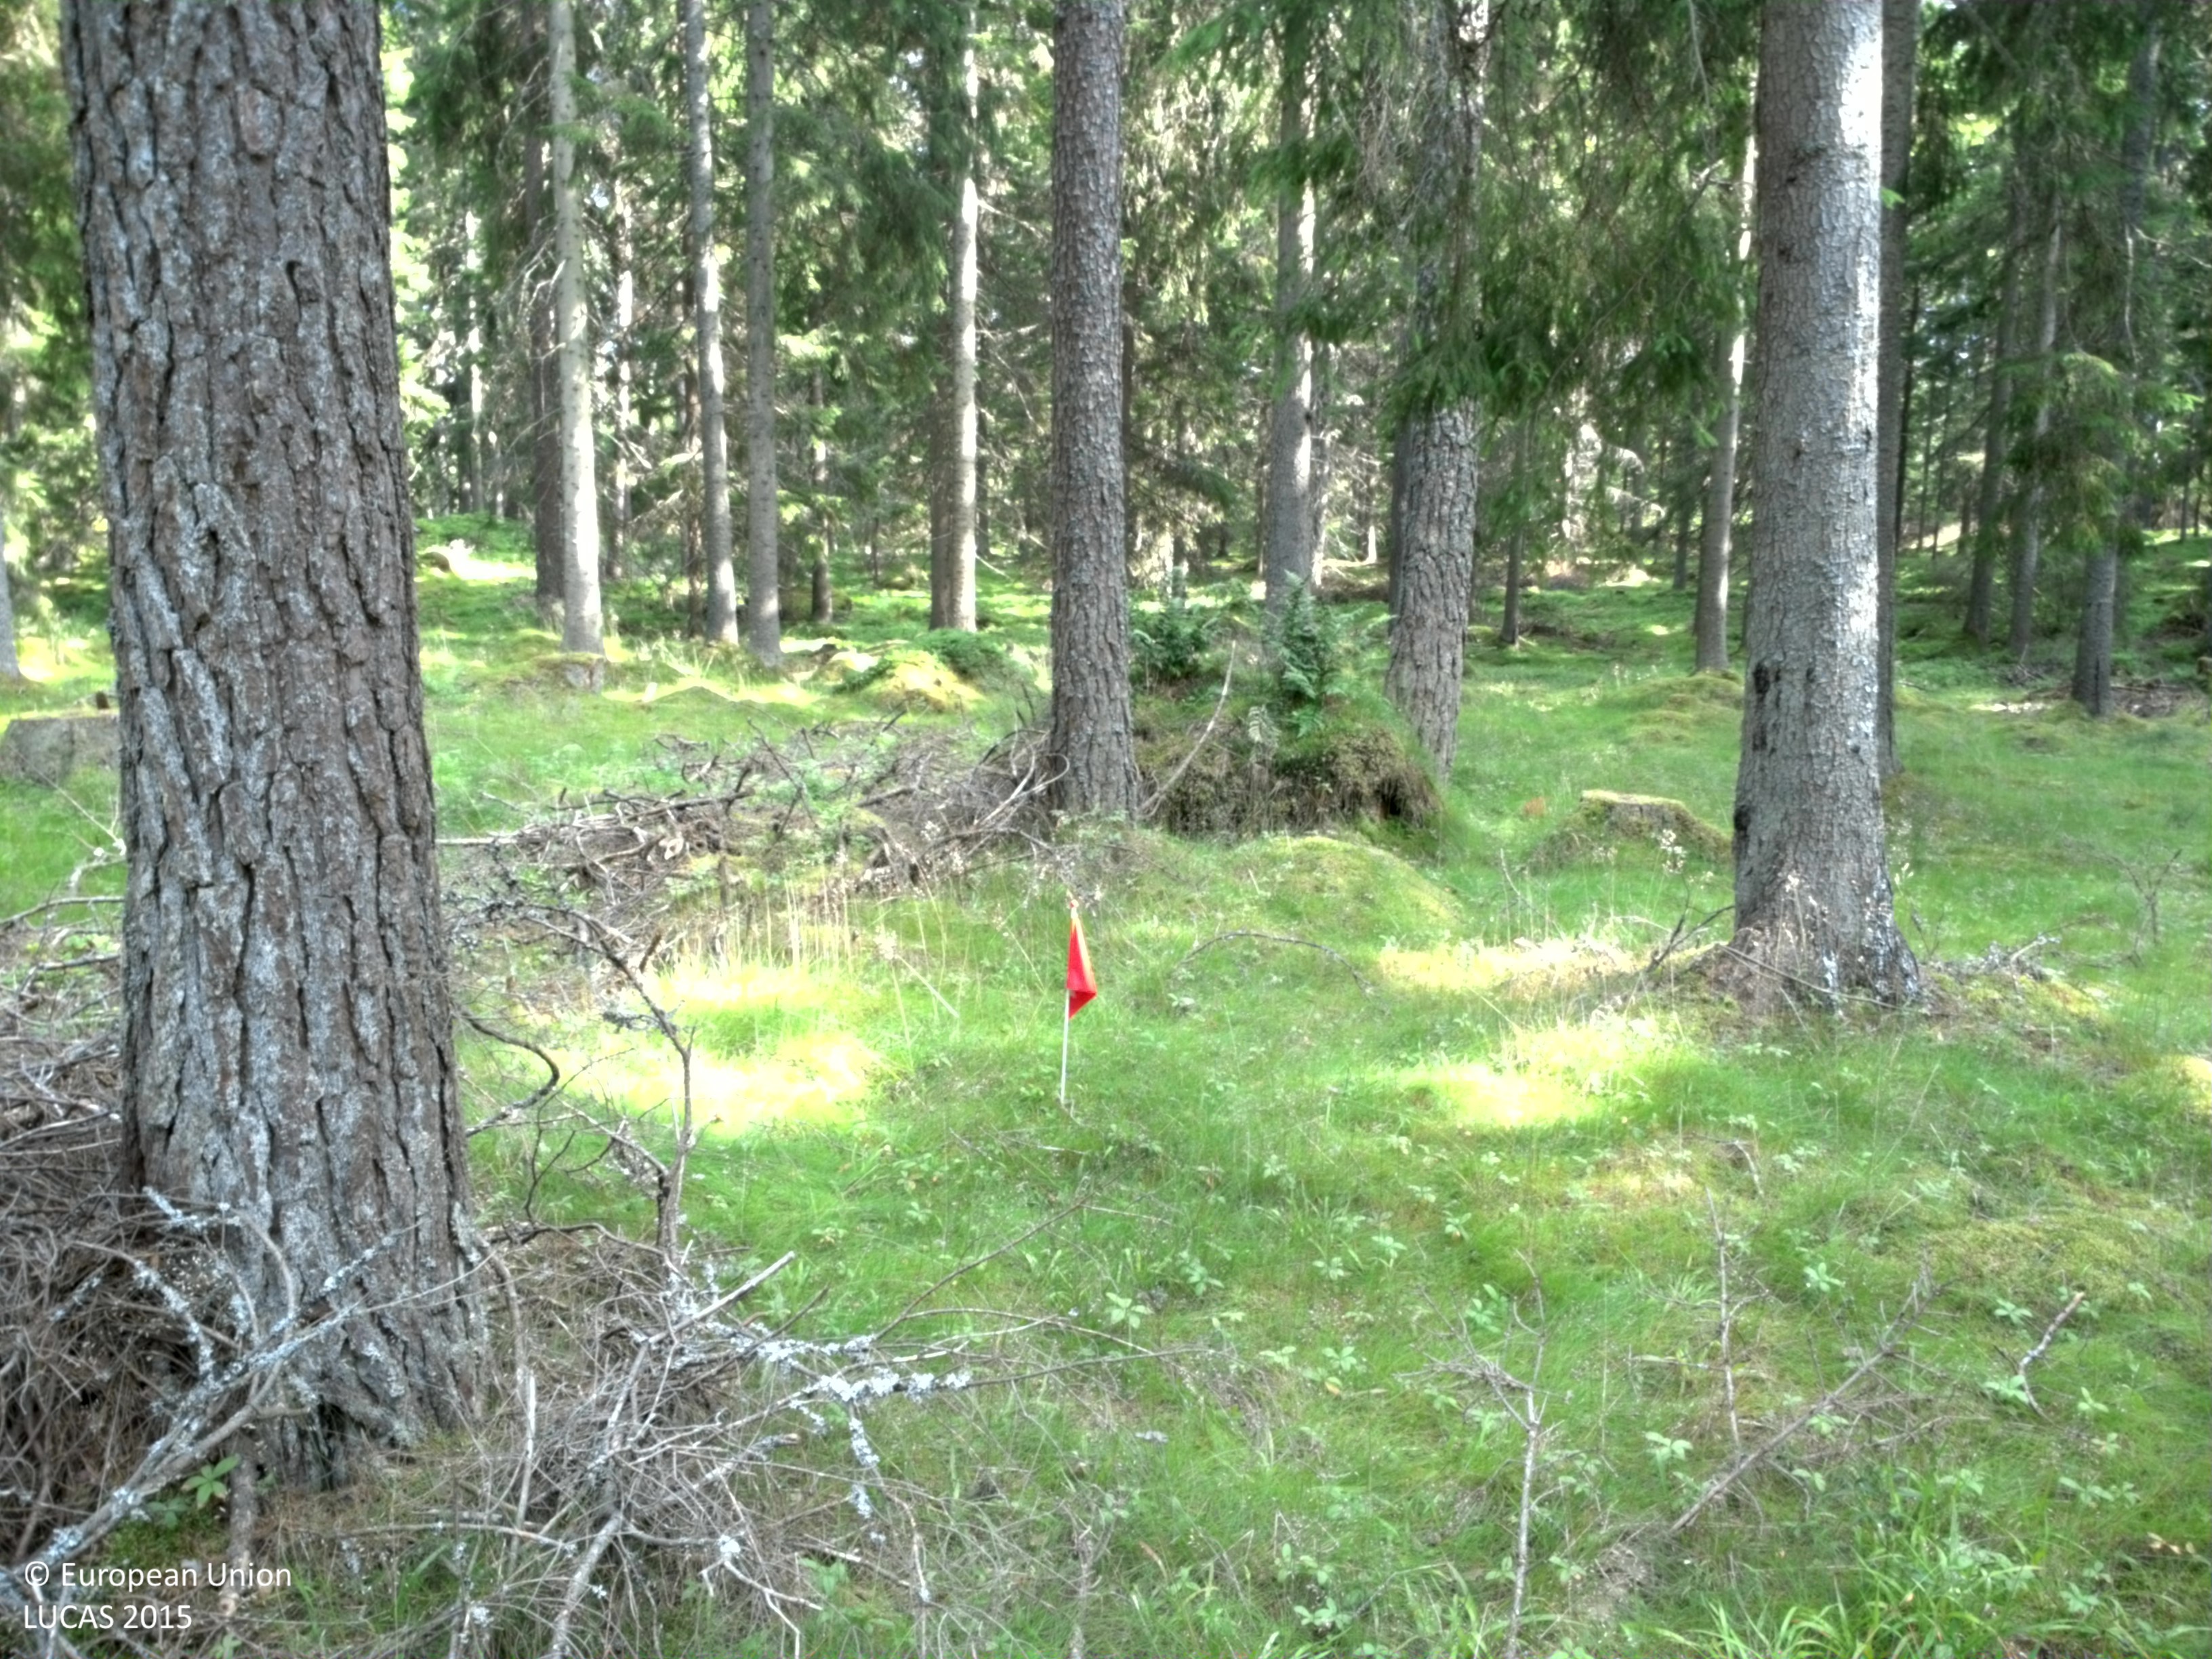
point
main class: Woodland
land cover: Other coniferous woodland
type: boreal forest
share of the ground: 25 - 50 %
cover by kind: coniferous forest trees 45 %, lichens and mosses 30 %, herbaceous plants 25 %
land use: Forestry
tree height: > 5 m
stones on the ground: < 10 %
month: July
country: SE
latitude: 58.5100
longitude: 14.3360
